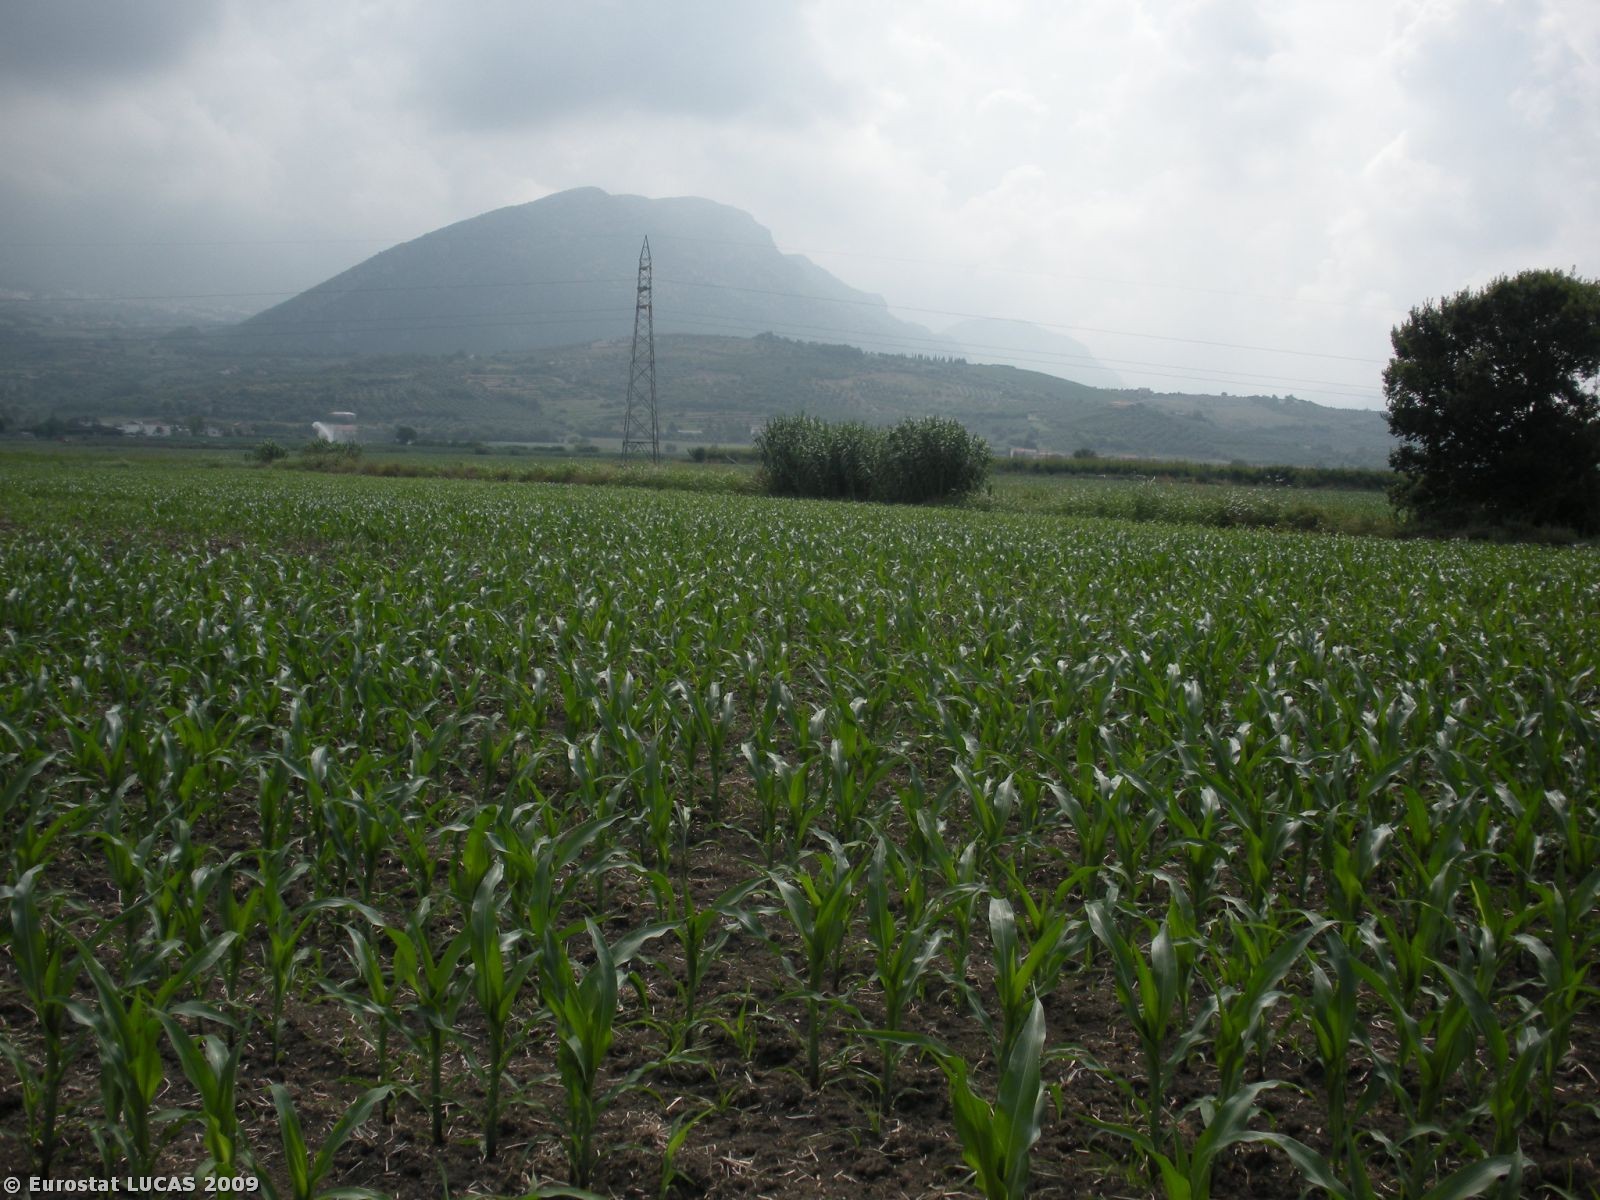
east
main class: Cropland
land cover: Maize
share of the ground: 25 - 50 %
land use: Agriculture (excluding fallow land and kitchen gardens)
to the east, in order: Maize; Grass margins; Ditches and canals; Grass margins; Maize; Electric lines; Maize
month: July
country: IT
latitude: 40.4100
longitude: 15.0336
